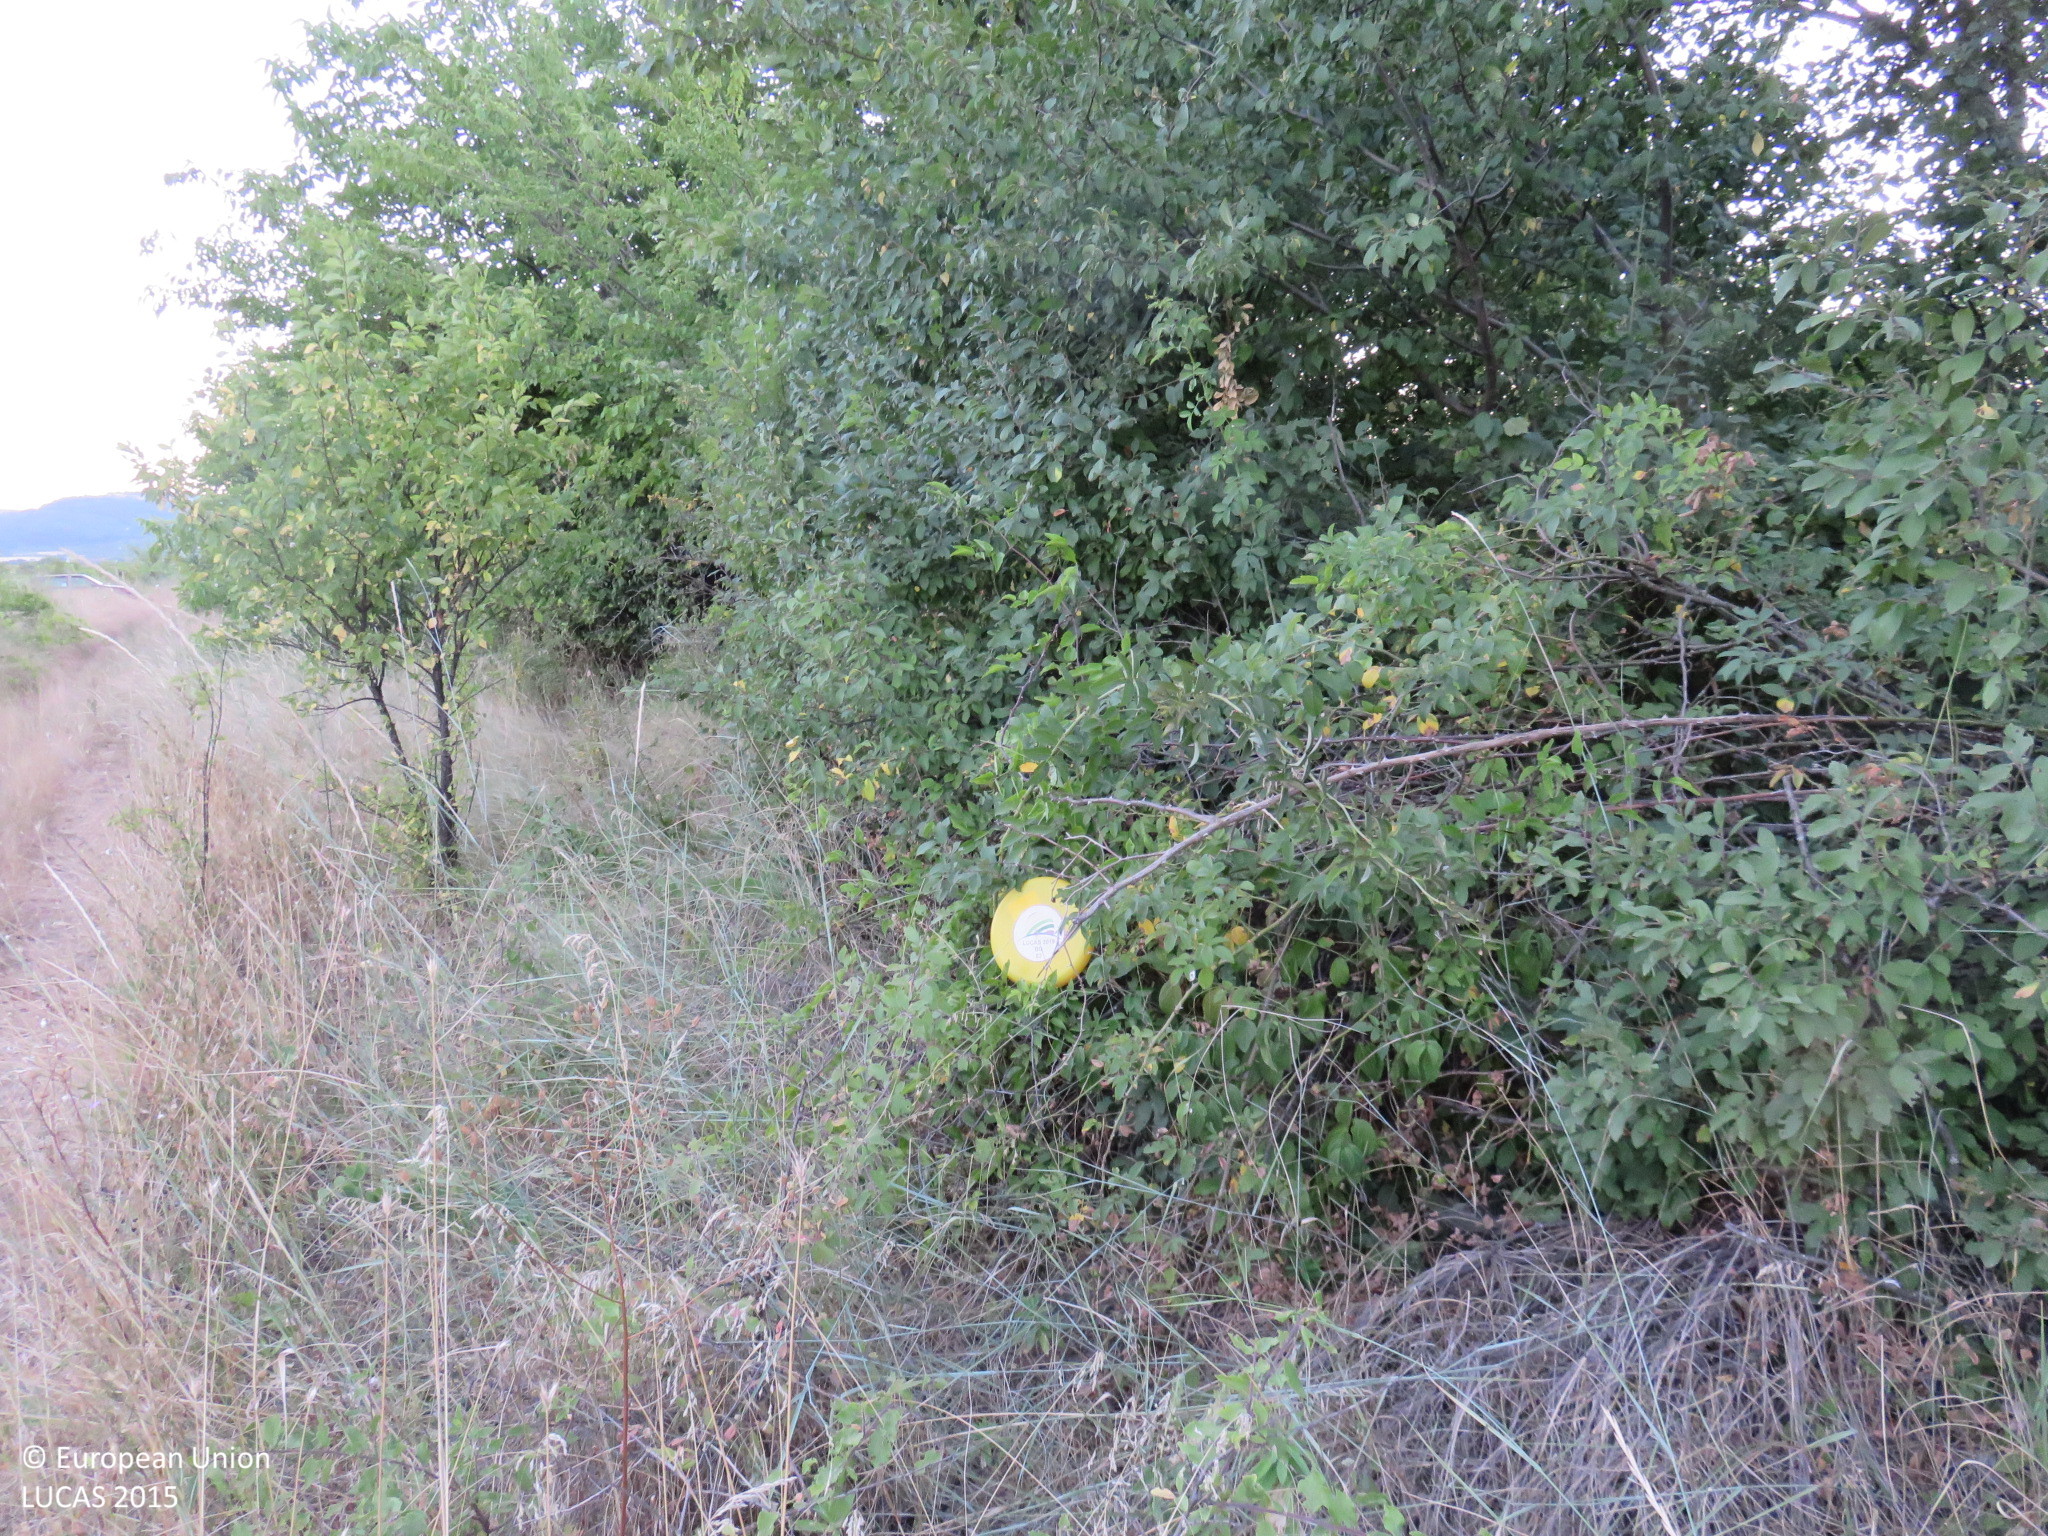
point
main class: Woodland
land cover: Broadleaved woodland
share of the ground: > 75 %
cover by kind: broadleaved forest trees 50 %, shrubs 50 %
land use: Semi-natural and natural areas not in use
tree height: > 5 m
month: July
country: BG
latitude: 43.1873
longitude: 25.1936
